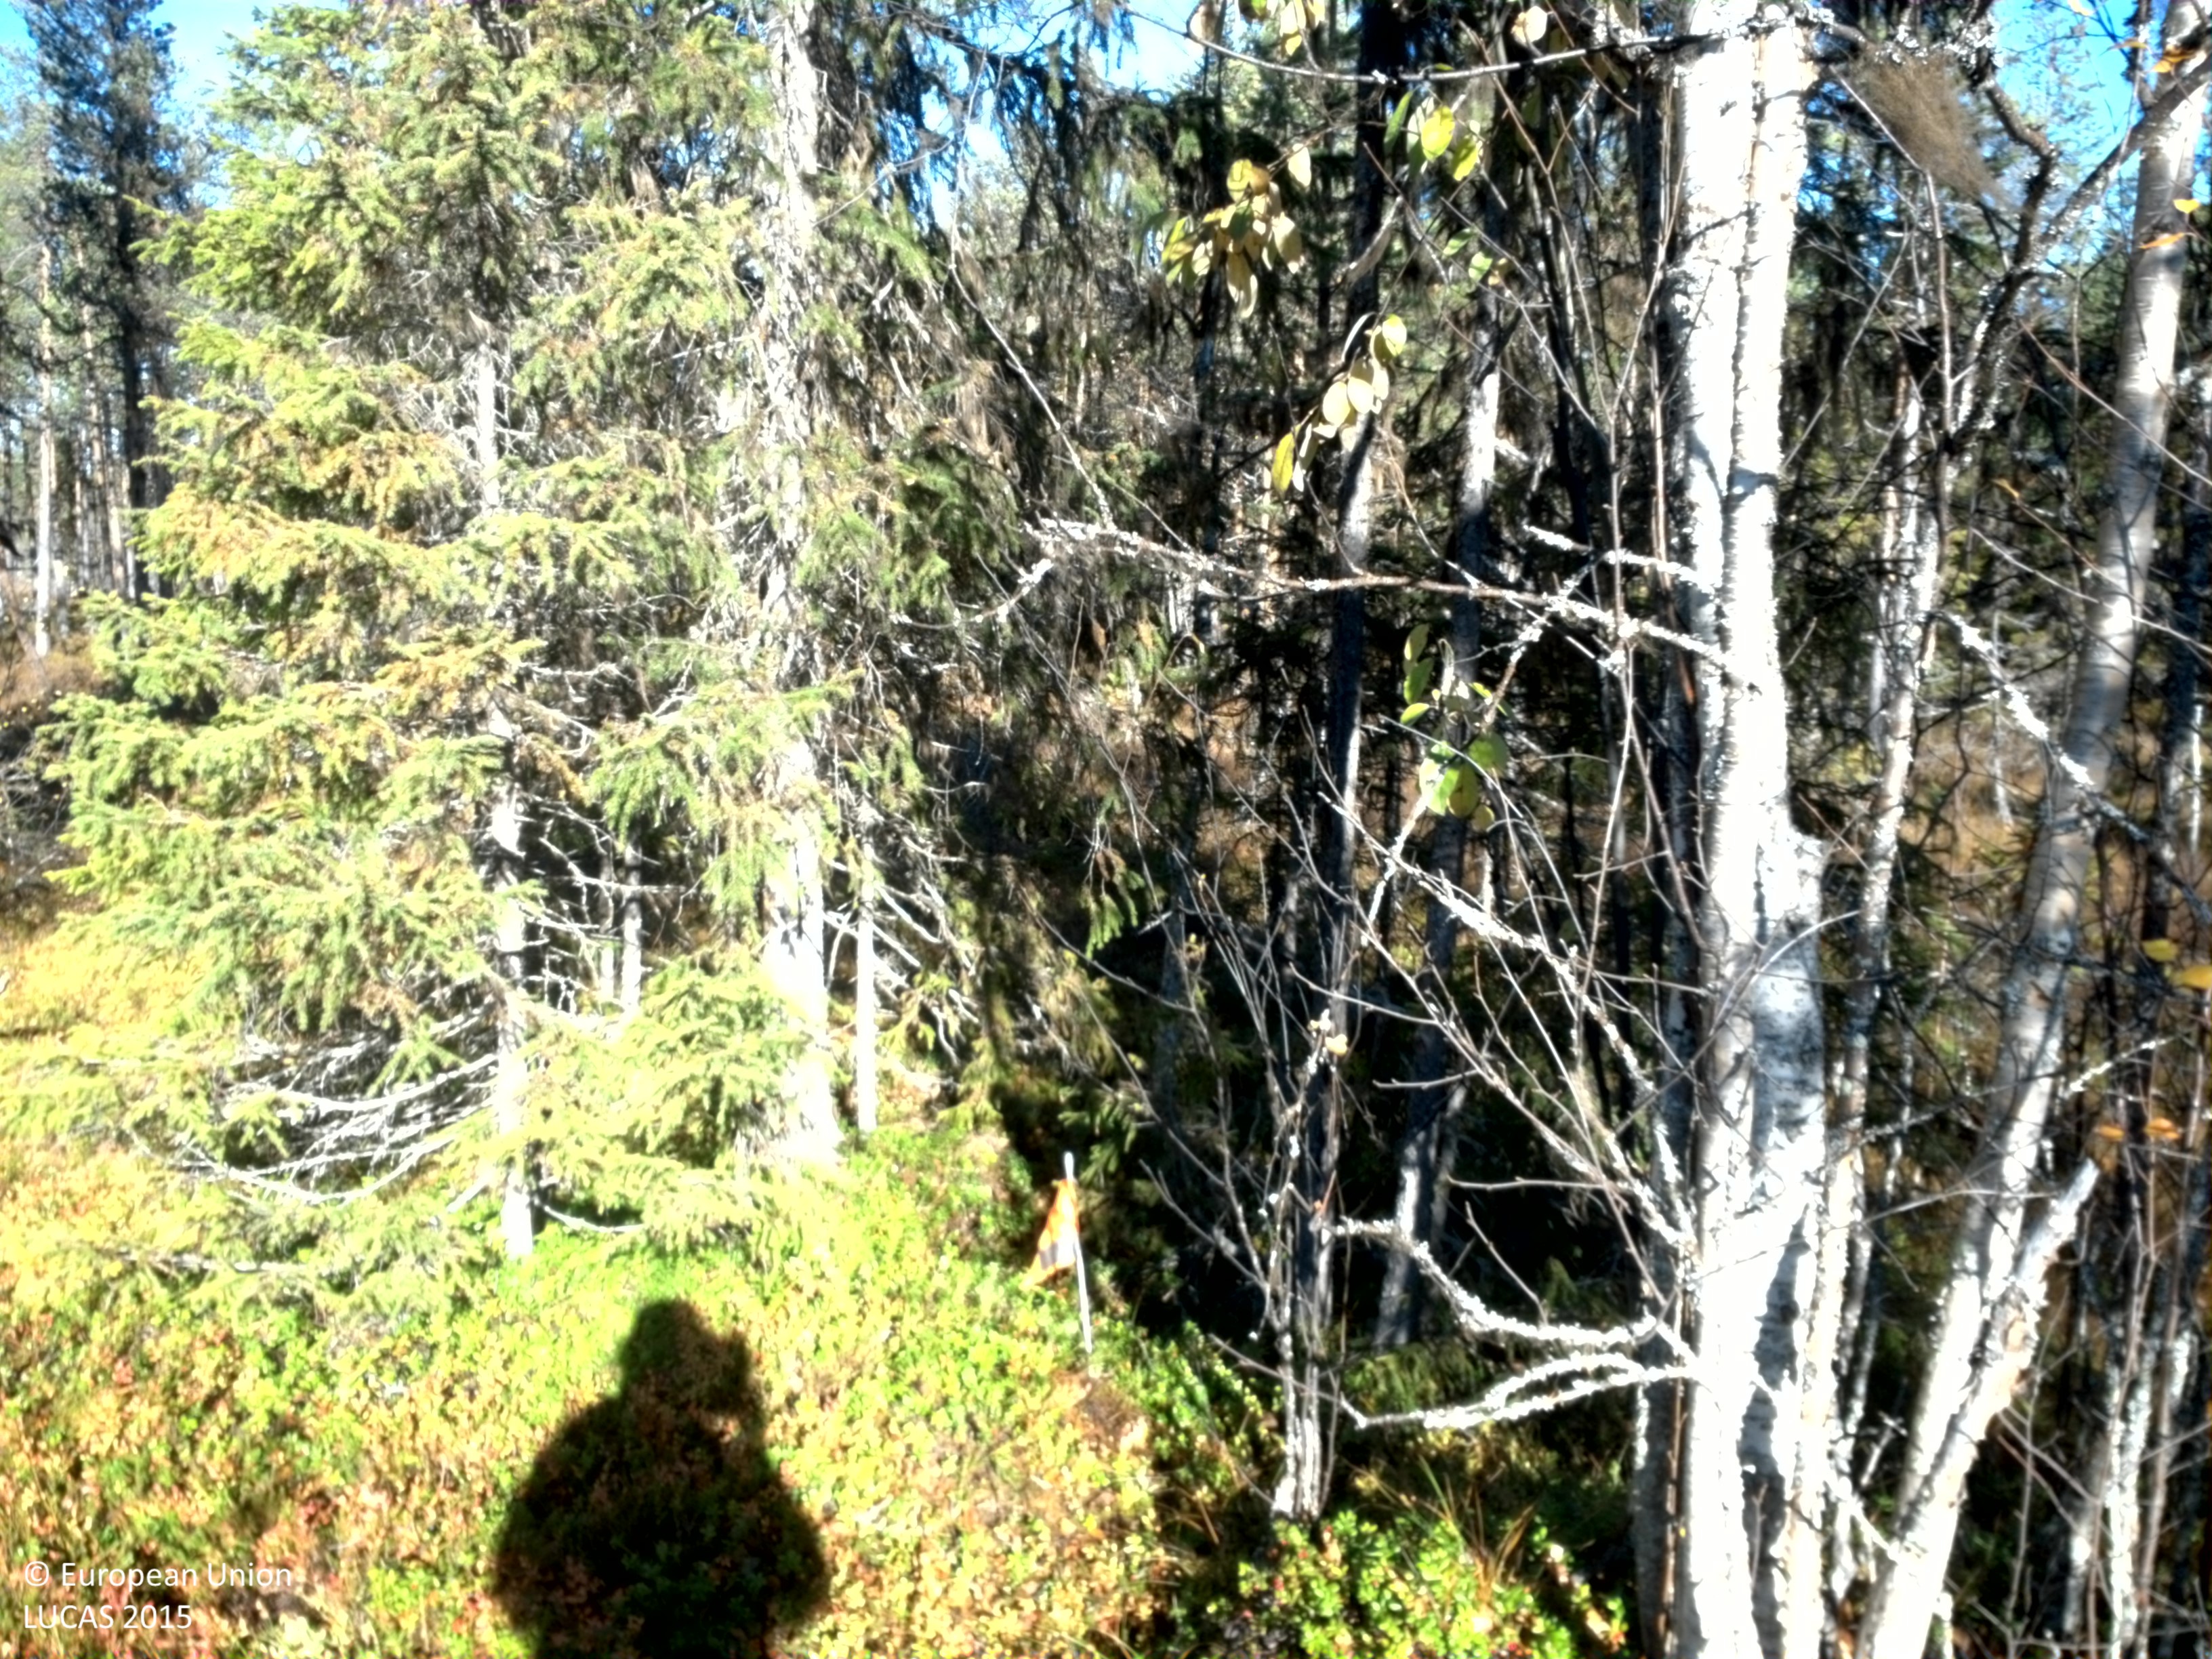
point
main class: Woodland
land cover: Spruce dominated mixed woodland
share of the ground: 25 - 50 %
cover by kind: shrubs 50 %, coniferous forest trees 20 %, broadleaved forest trees 15 %, lichens and mosses 10 %, herbaceous plants 5 %
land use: Forestry
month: September
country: SE
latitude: 64.9681
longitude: 17.8221
